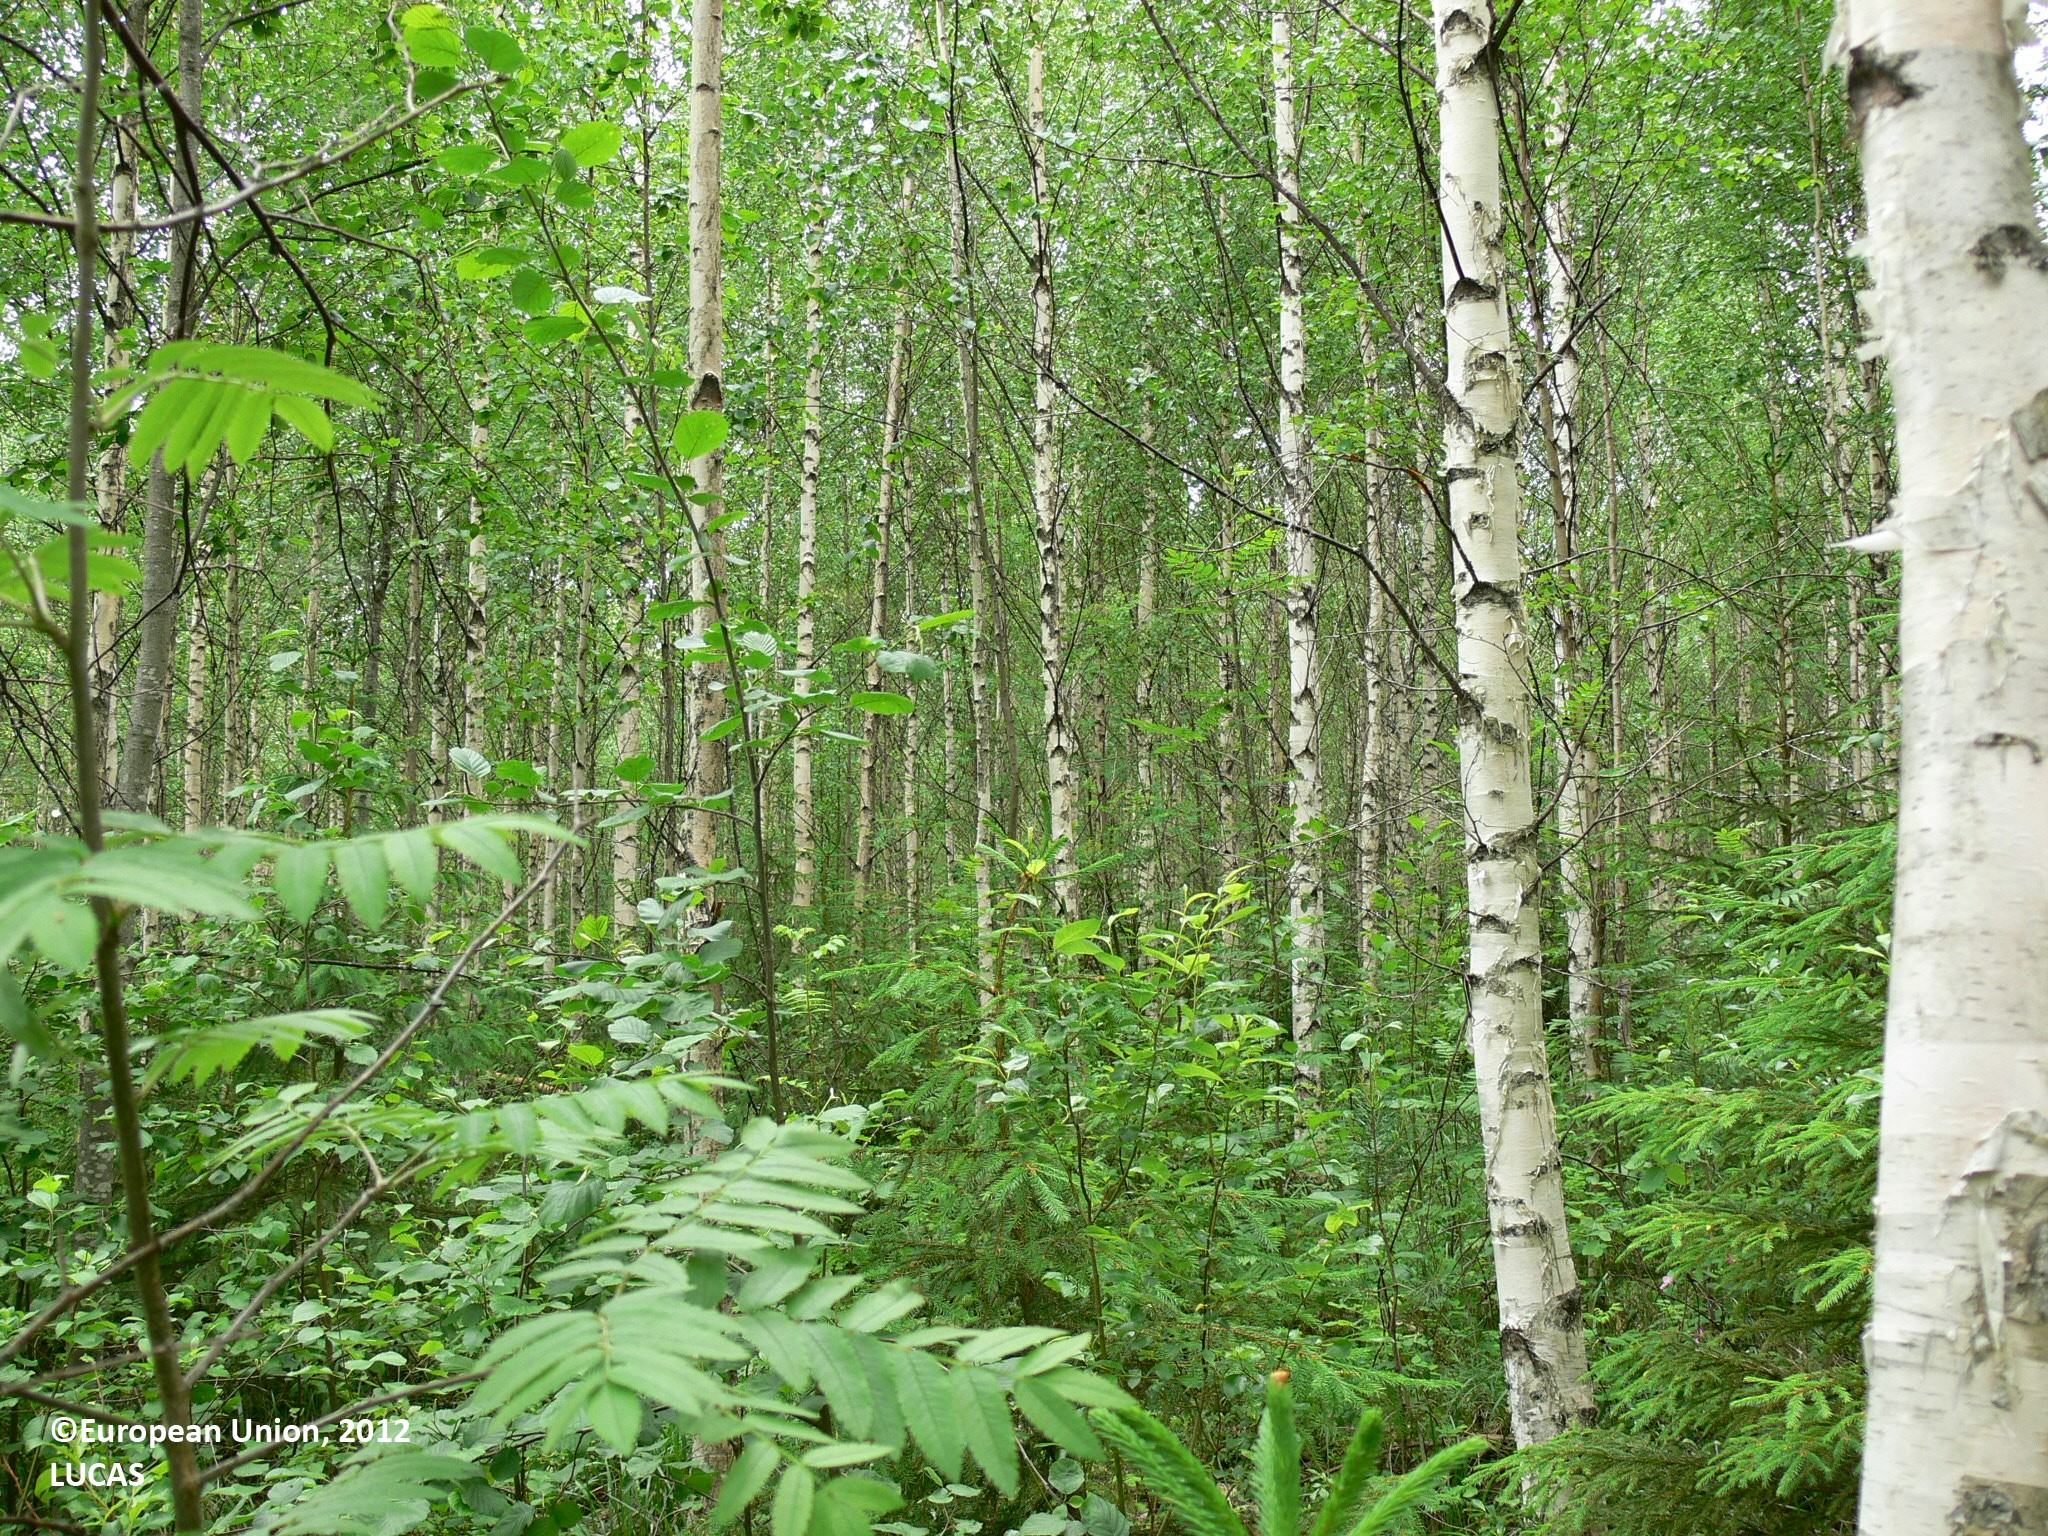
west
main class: Woodland
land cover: Broadleaved woodland
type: boreal forest
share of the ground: > 75 %
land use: Forestry
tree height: > 5 m
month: June
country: FI
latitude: 62.7957
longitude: 30.4522
